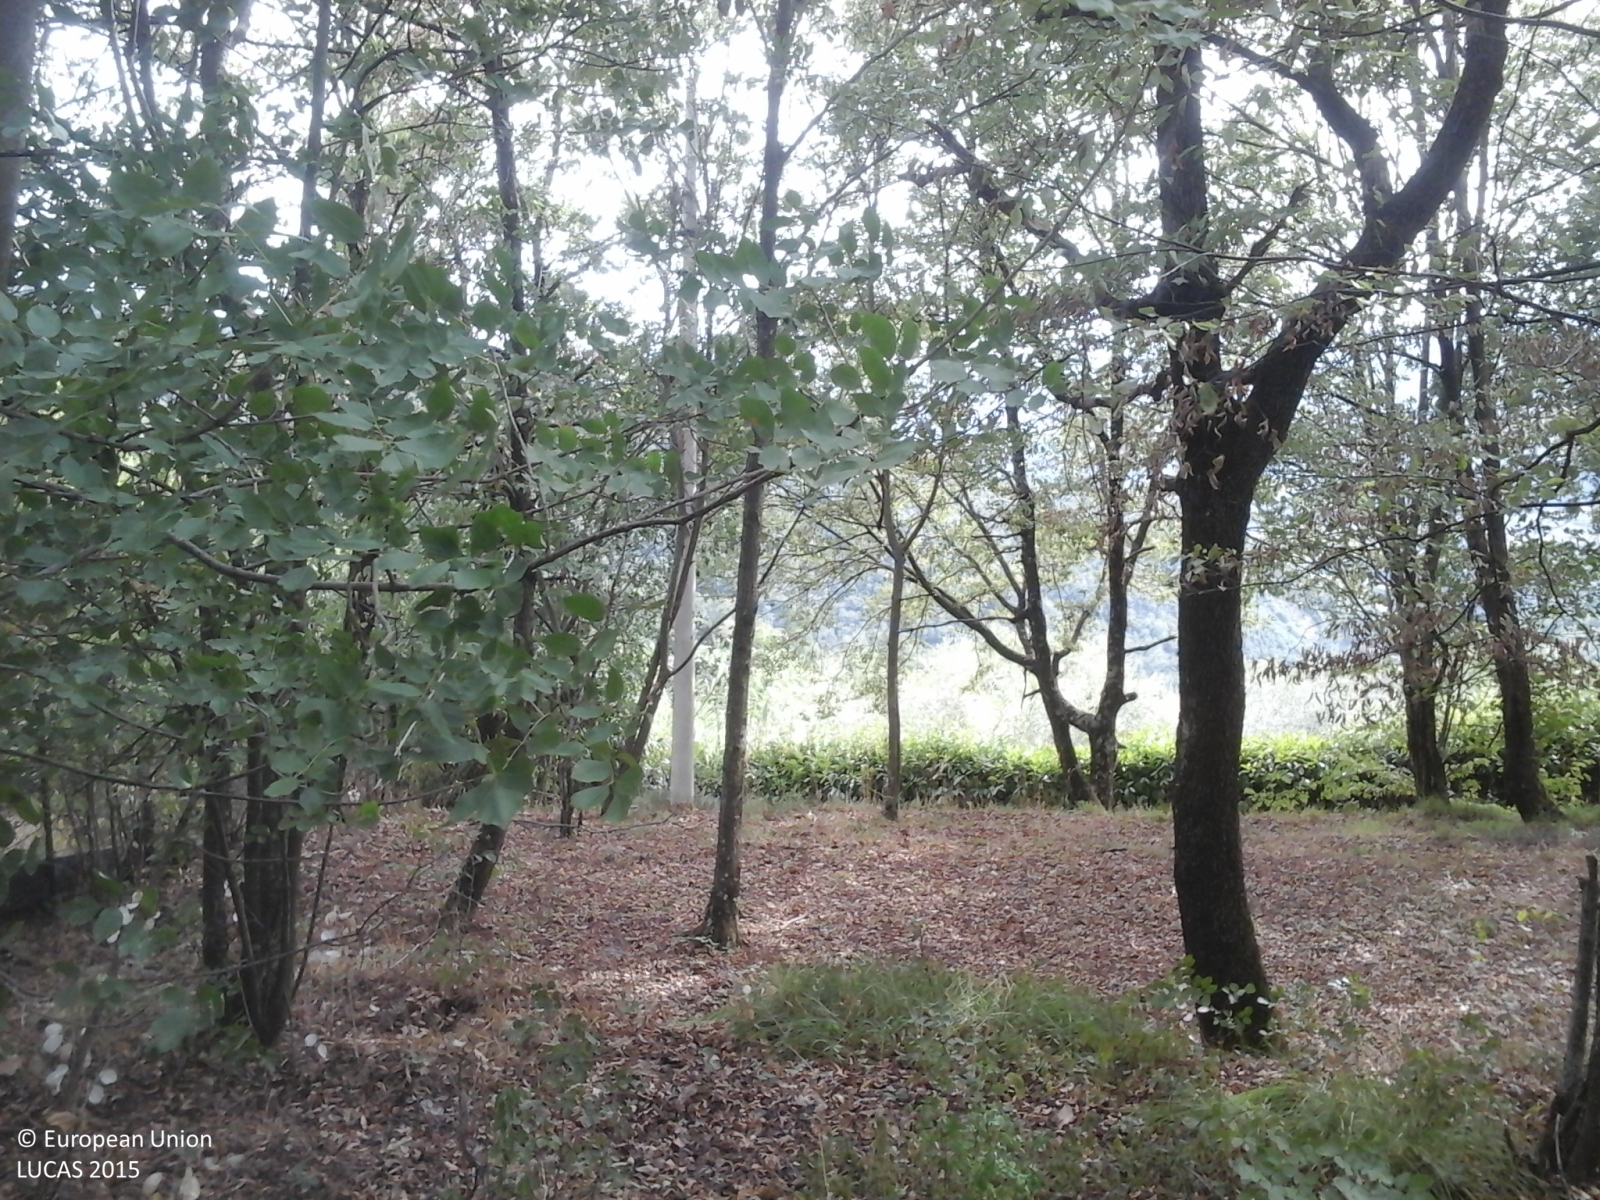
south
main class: Woodland
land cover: Broadleaved woodland
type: thermophilous deciduous forest
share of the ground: > 75 %
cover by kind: broadleaved forest trees 100 %
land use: Forestry
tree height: > 5 m
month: August
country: IT
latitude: 44.0038
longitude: 10.9082
